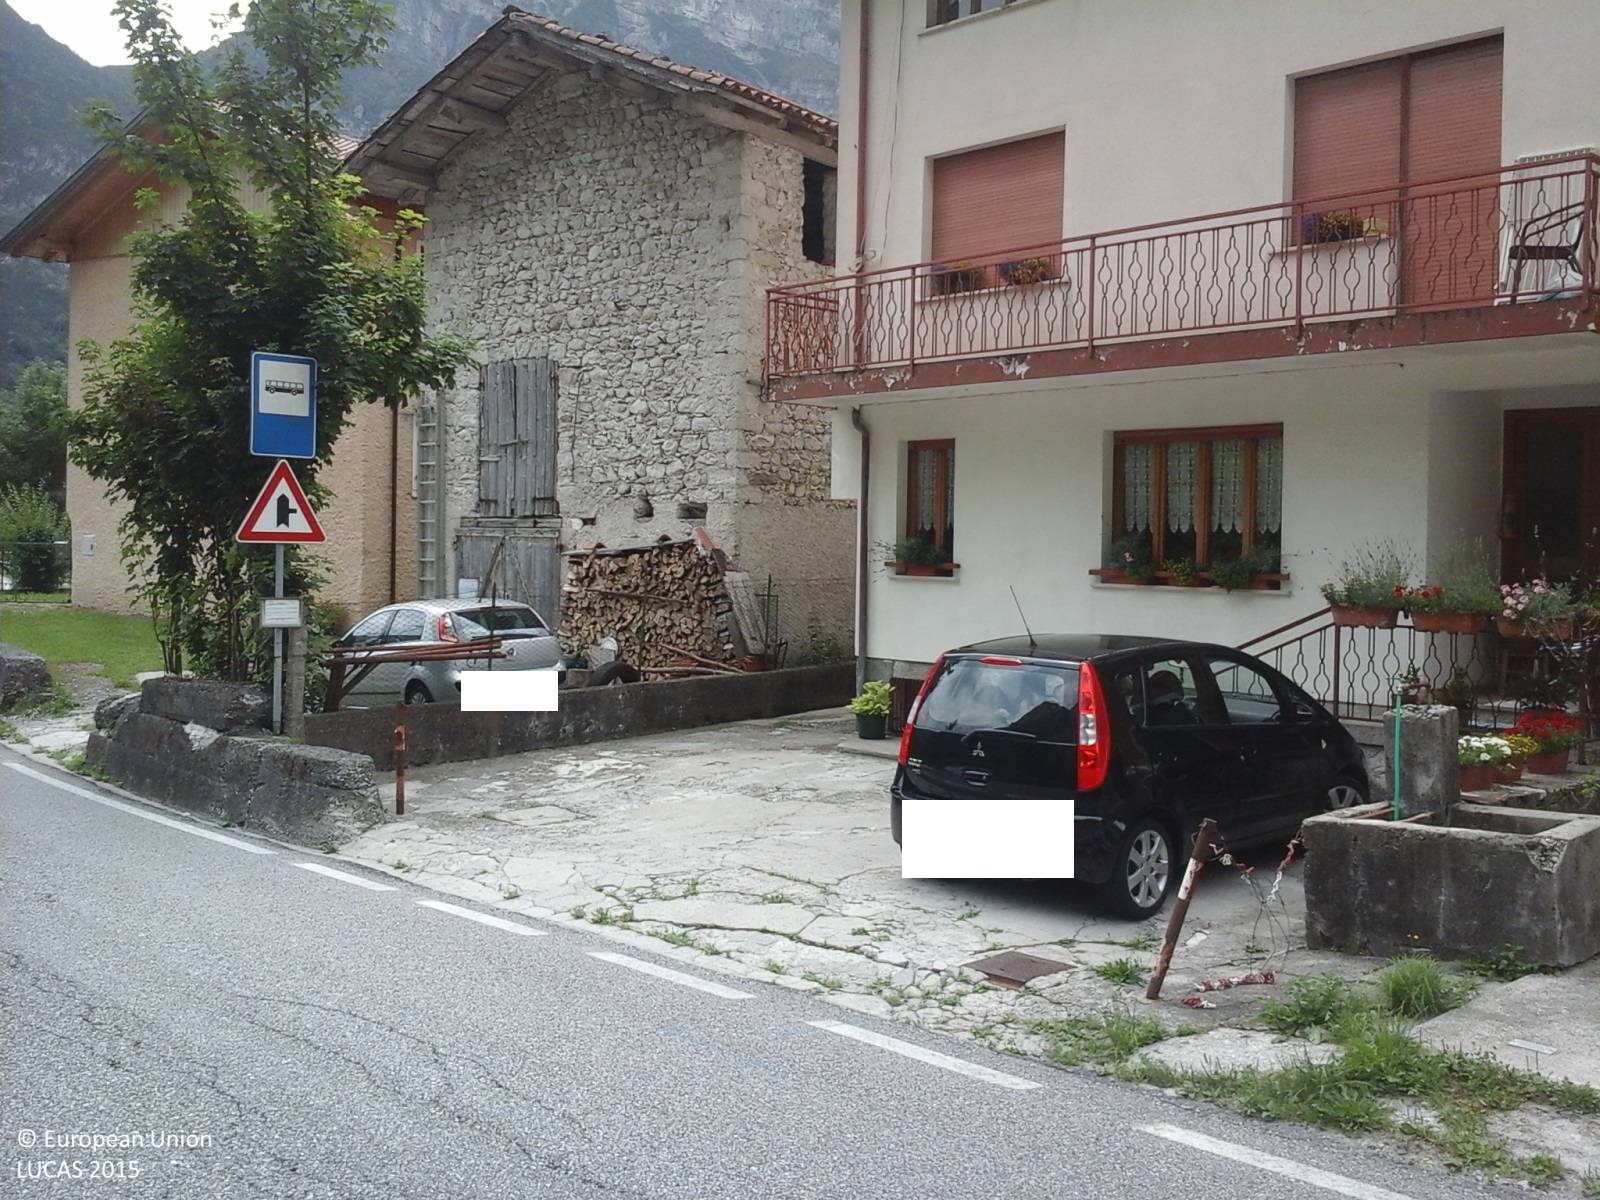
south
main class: Woodland
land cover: Broadleaved woodland
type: mountainous beech forest
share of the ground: > 75 %
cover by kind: broadleaved forest trees 80 %, coniferous forest trees 20 %
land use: Semi-natural and natural areas not in use
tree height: > 5 m
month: July
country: IT
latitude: 46.2505
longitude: 12.4746
